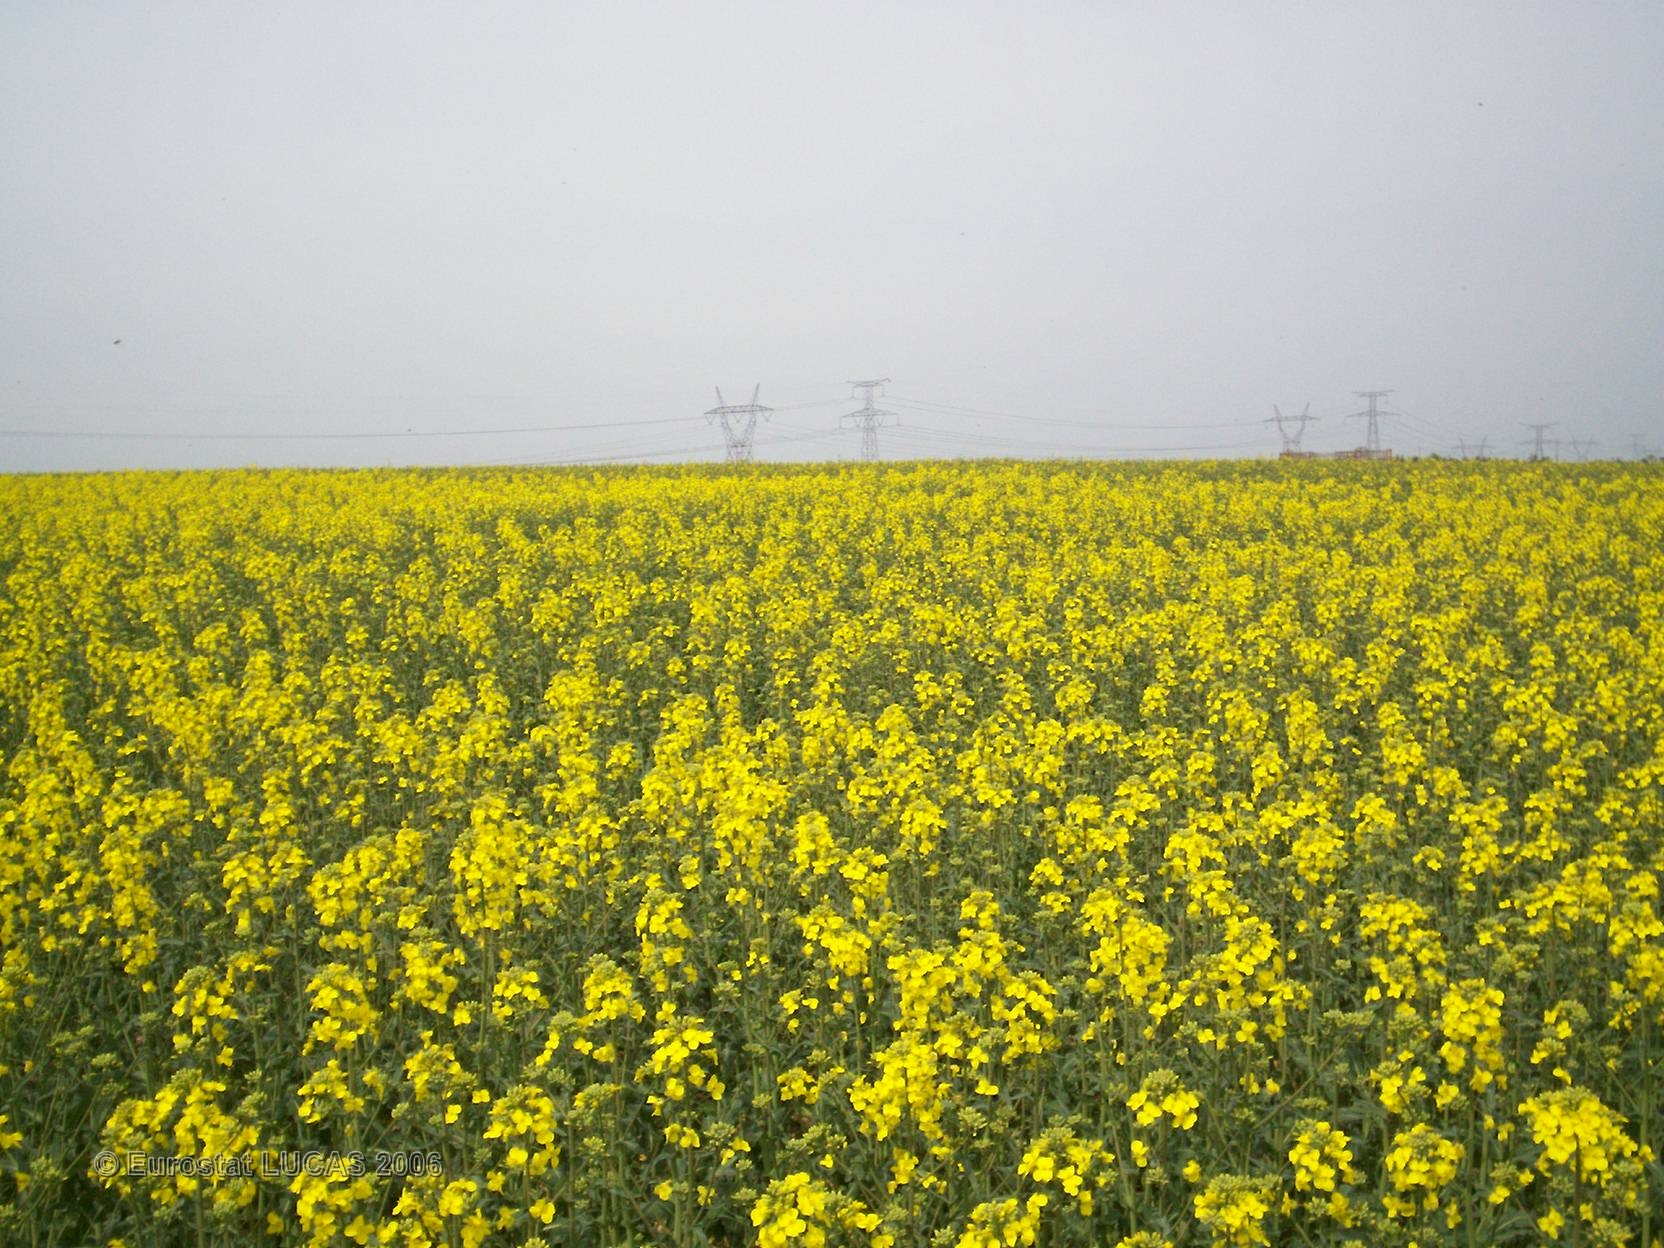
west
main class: Cropland
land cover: Rape and turnip rape
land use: Agriculture (excluding fallow land and kitchen gardens)
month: May
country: FR
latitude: 47.6202
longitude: 4.5570
